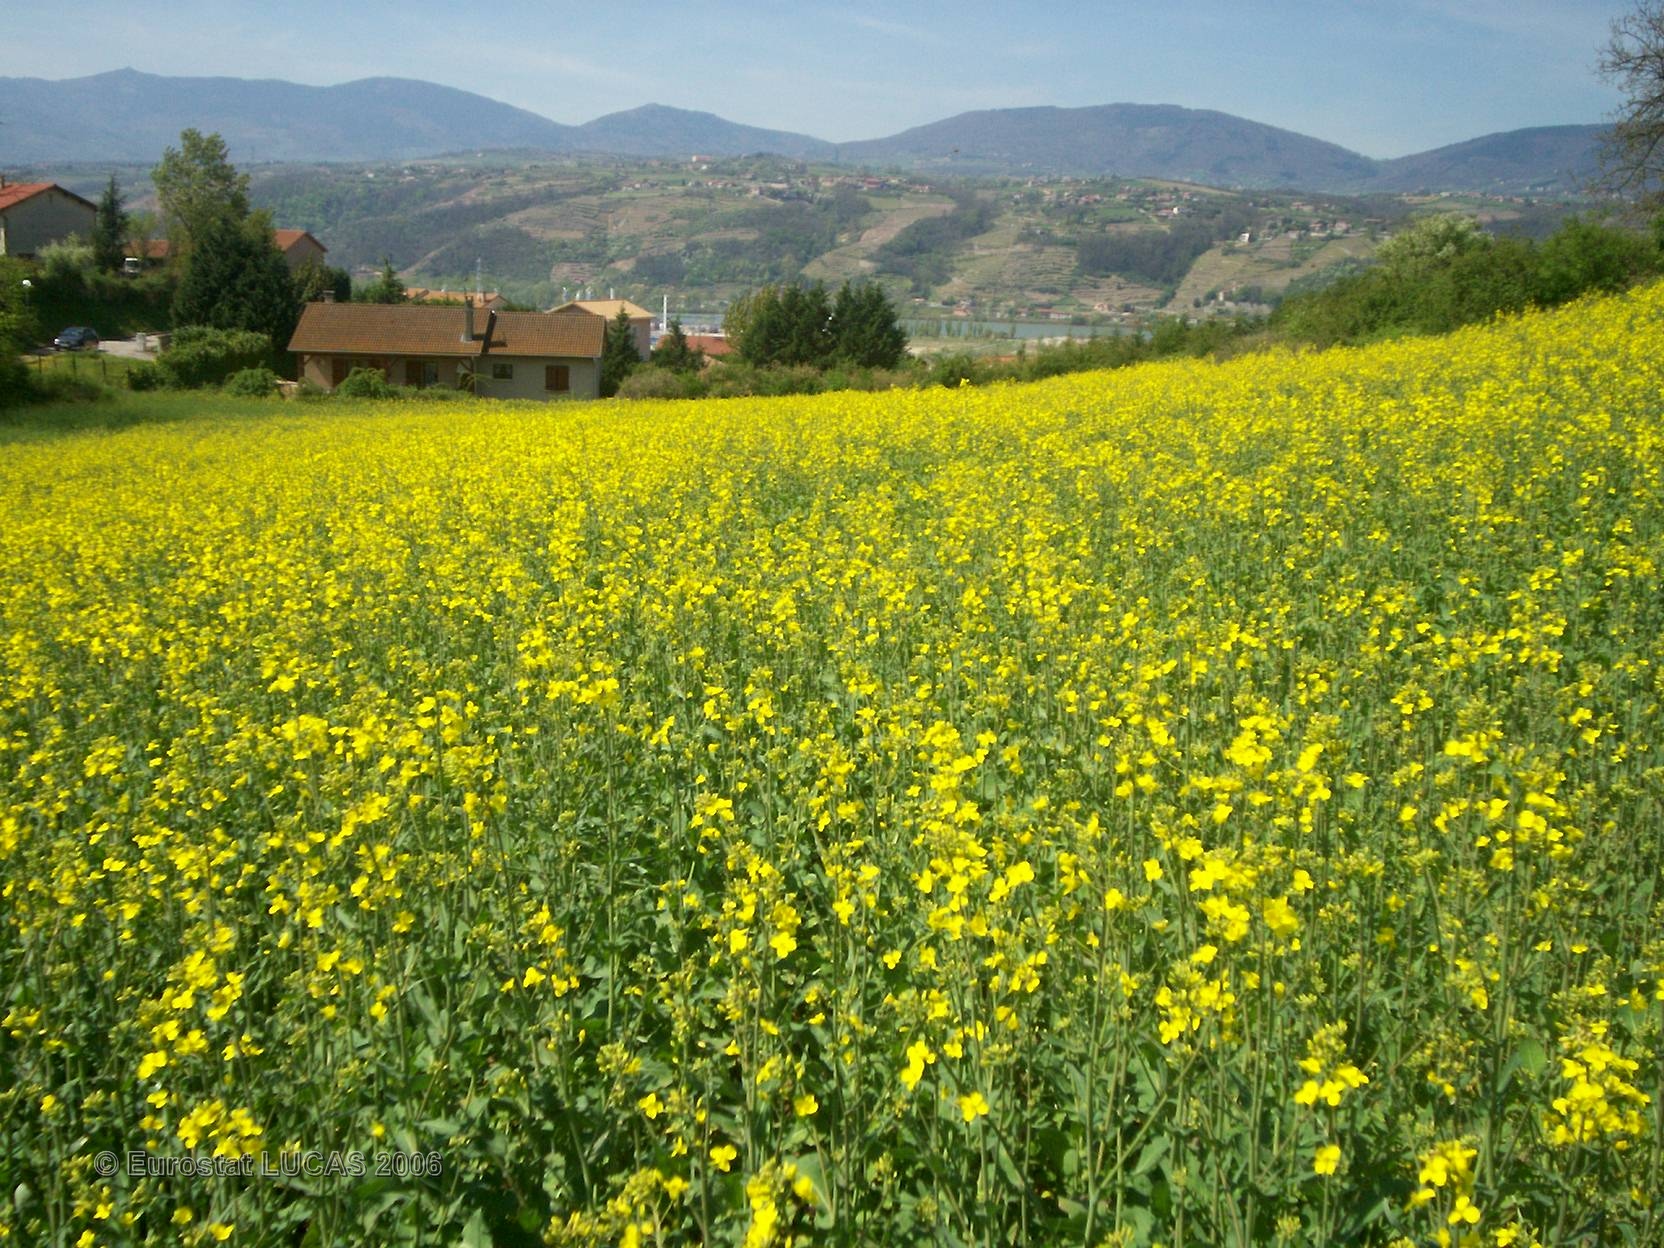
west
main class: Cropland
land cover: Rape and turnip rape
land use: Agriculture (excluding fallow land and kitchen gardens)
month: April
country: FR
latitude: 45.4473
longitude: 4.7749
